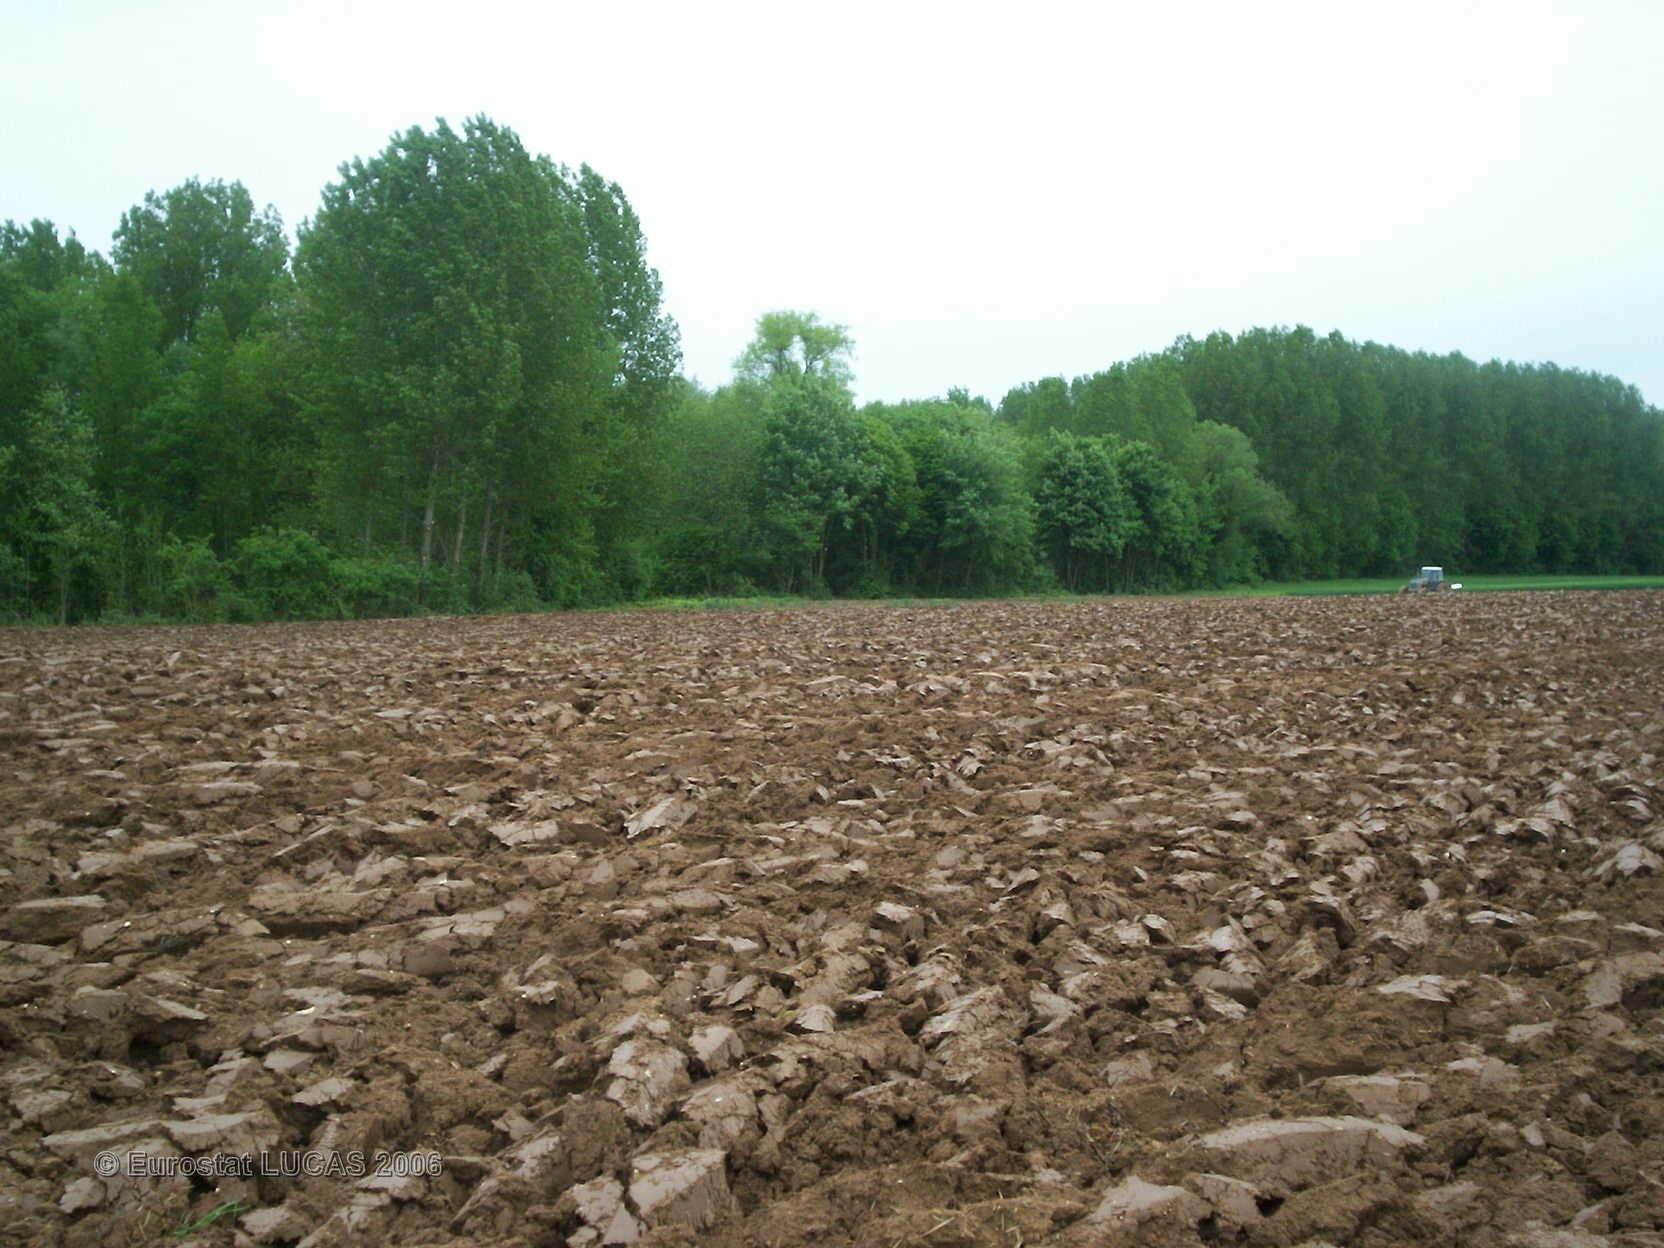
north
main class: Cropland
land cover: Maize
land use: Agriculture (excluding fallow land and kitchen gardens)
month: June
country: FR
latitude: 50.2844
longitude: 2.5636
